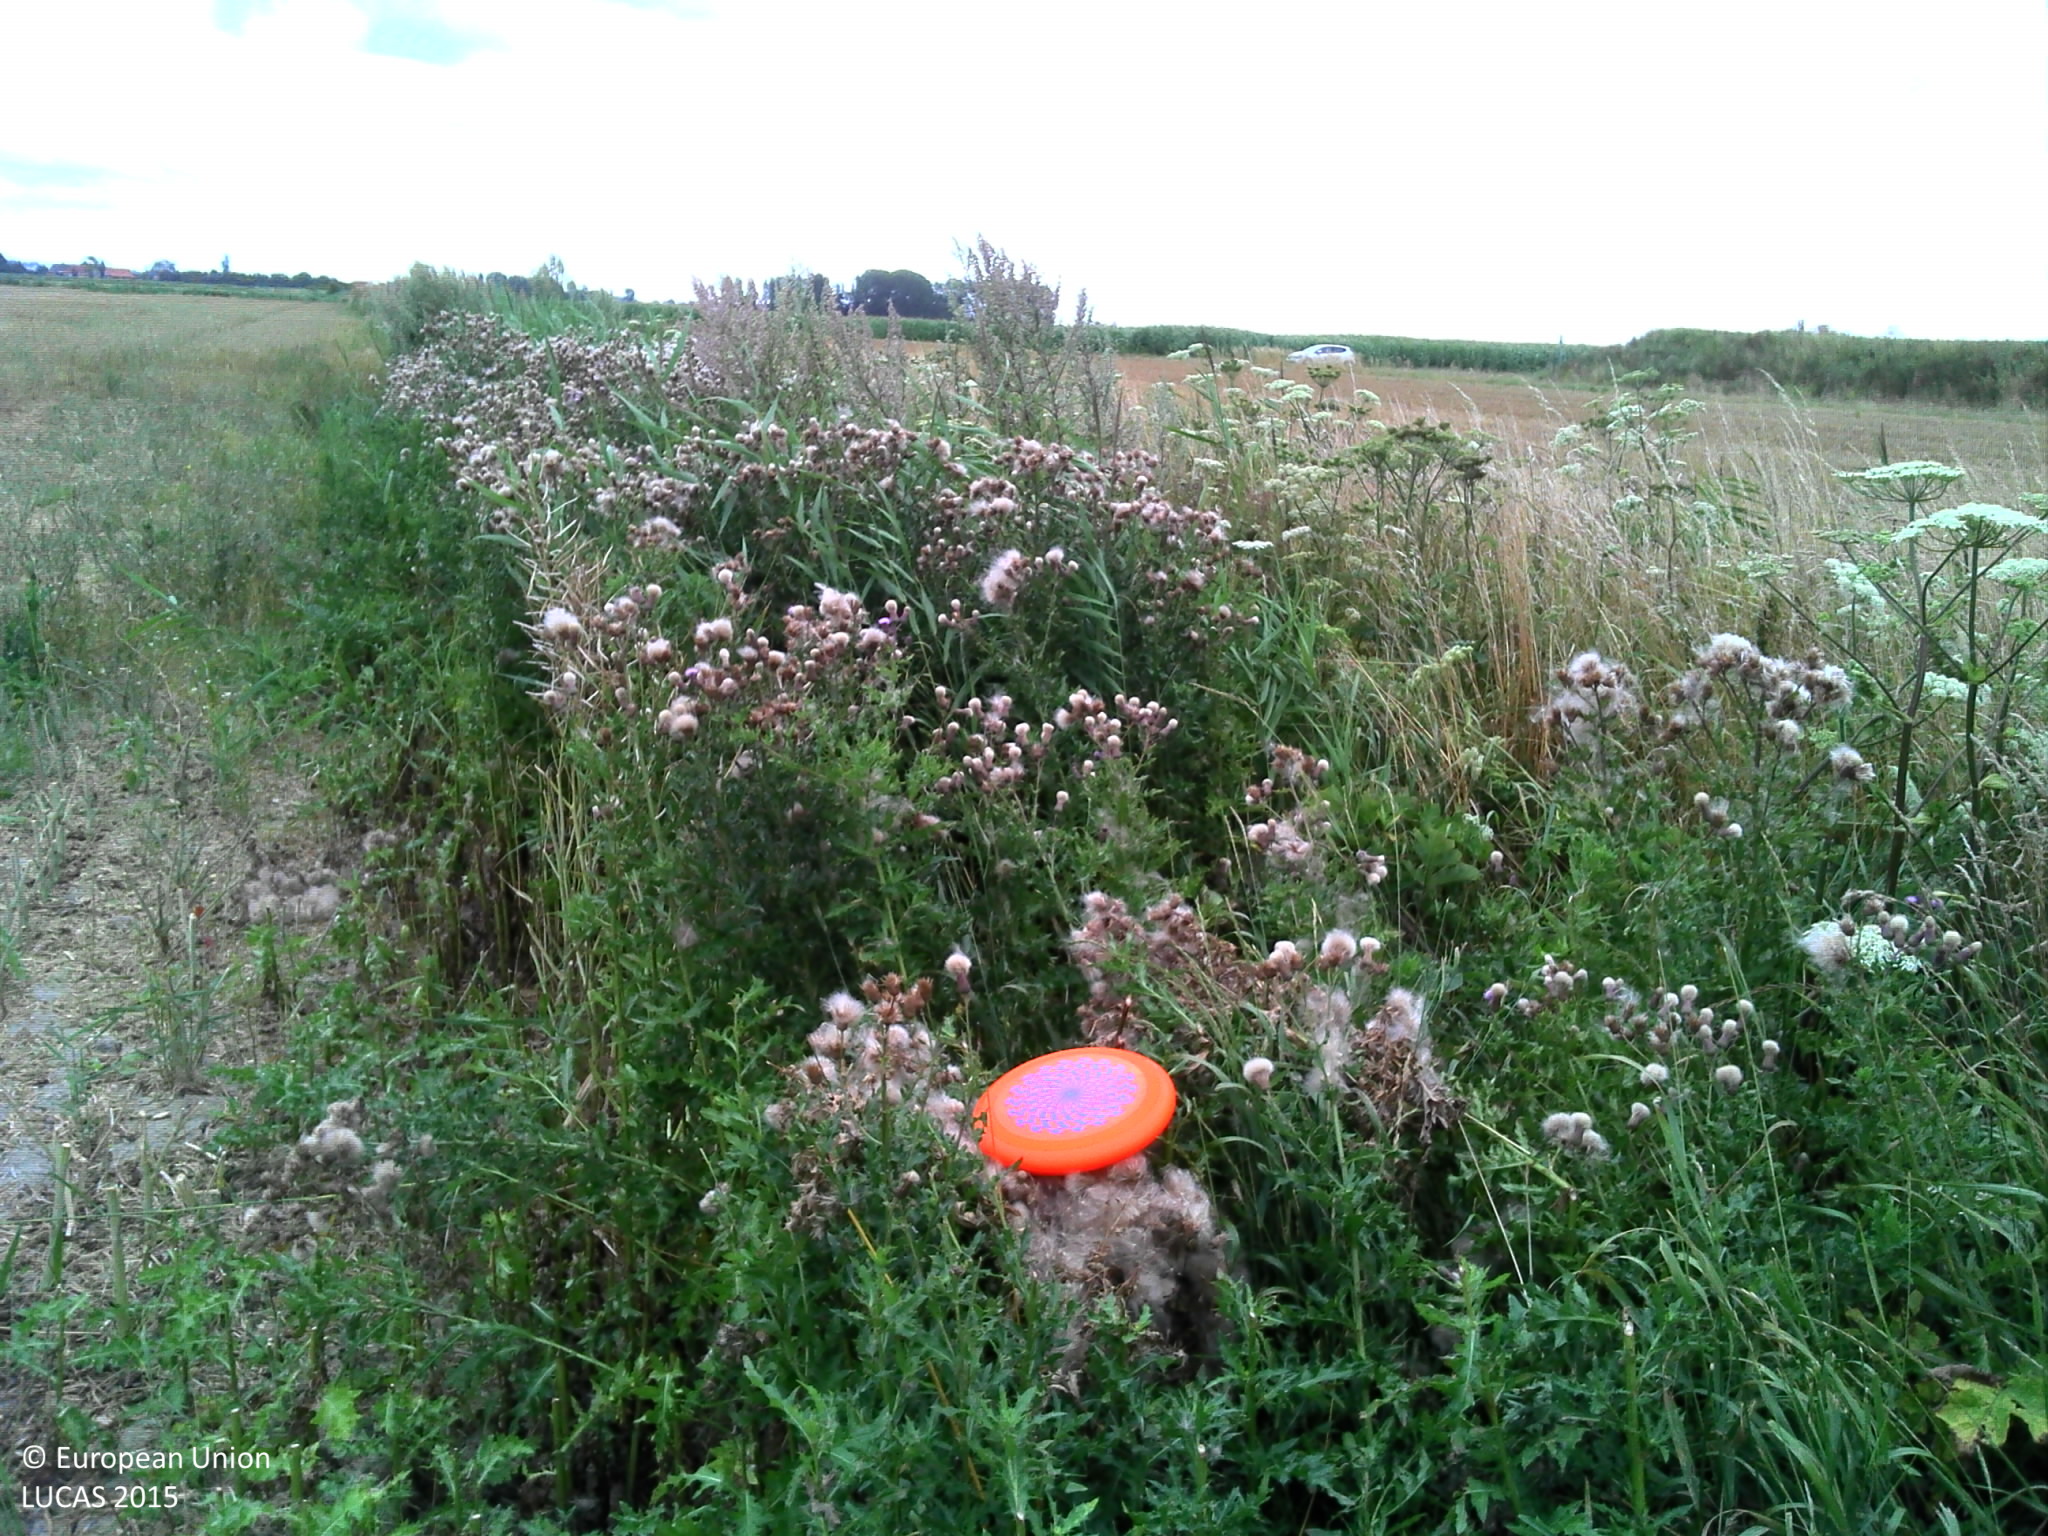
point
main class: Cropland
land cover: Rape and turnip rape
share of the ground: 10 - 25 %
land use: Agriculture (excluding fallow land and kitchen gardens)
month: August
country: FR
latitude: 50.9031
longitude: 2.0926
